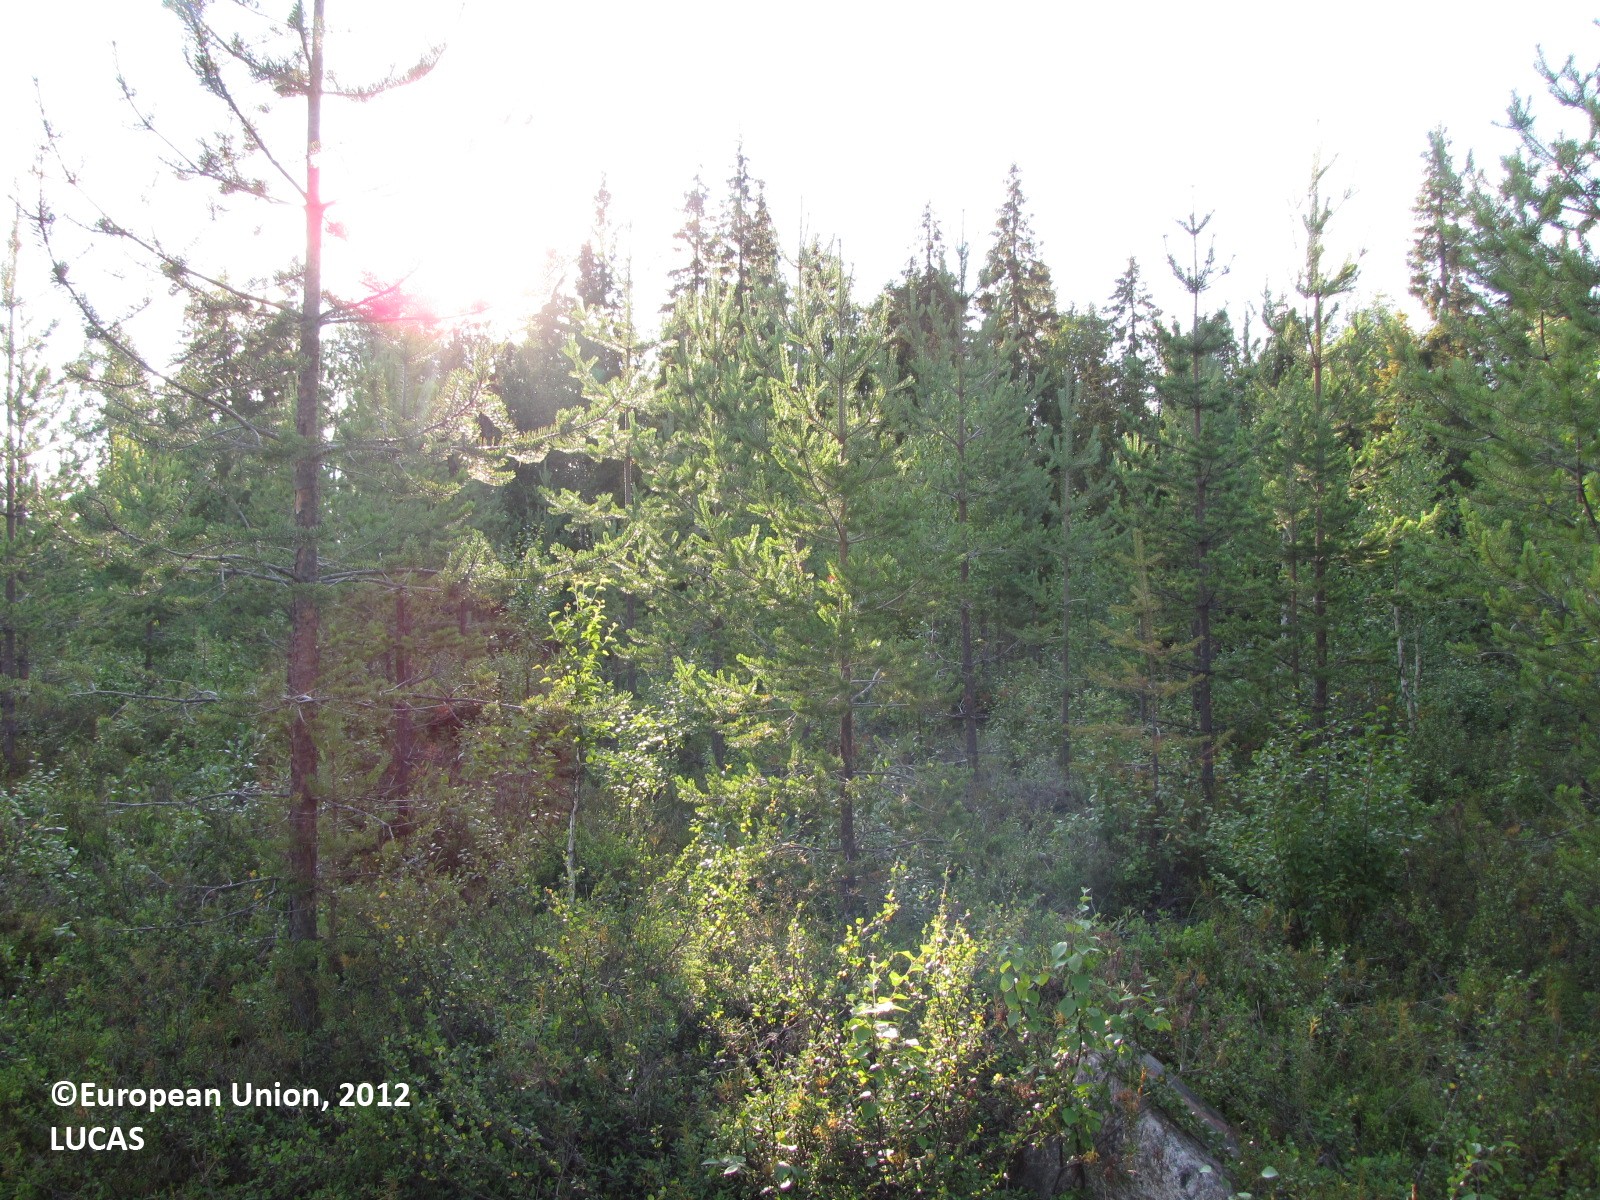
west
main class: Woodland
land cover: Pine dominated coniferous woodland
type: boreal forest
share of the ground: 50 - 75 %
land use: Forestry
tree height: < 5 m
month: July
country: FI
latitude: 66.7013
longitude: 24.4740
